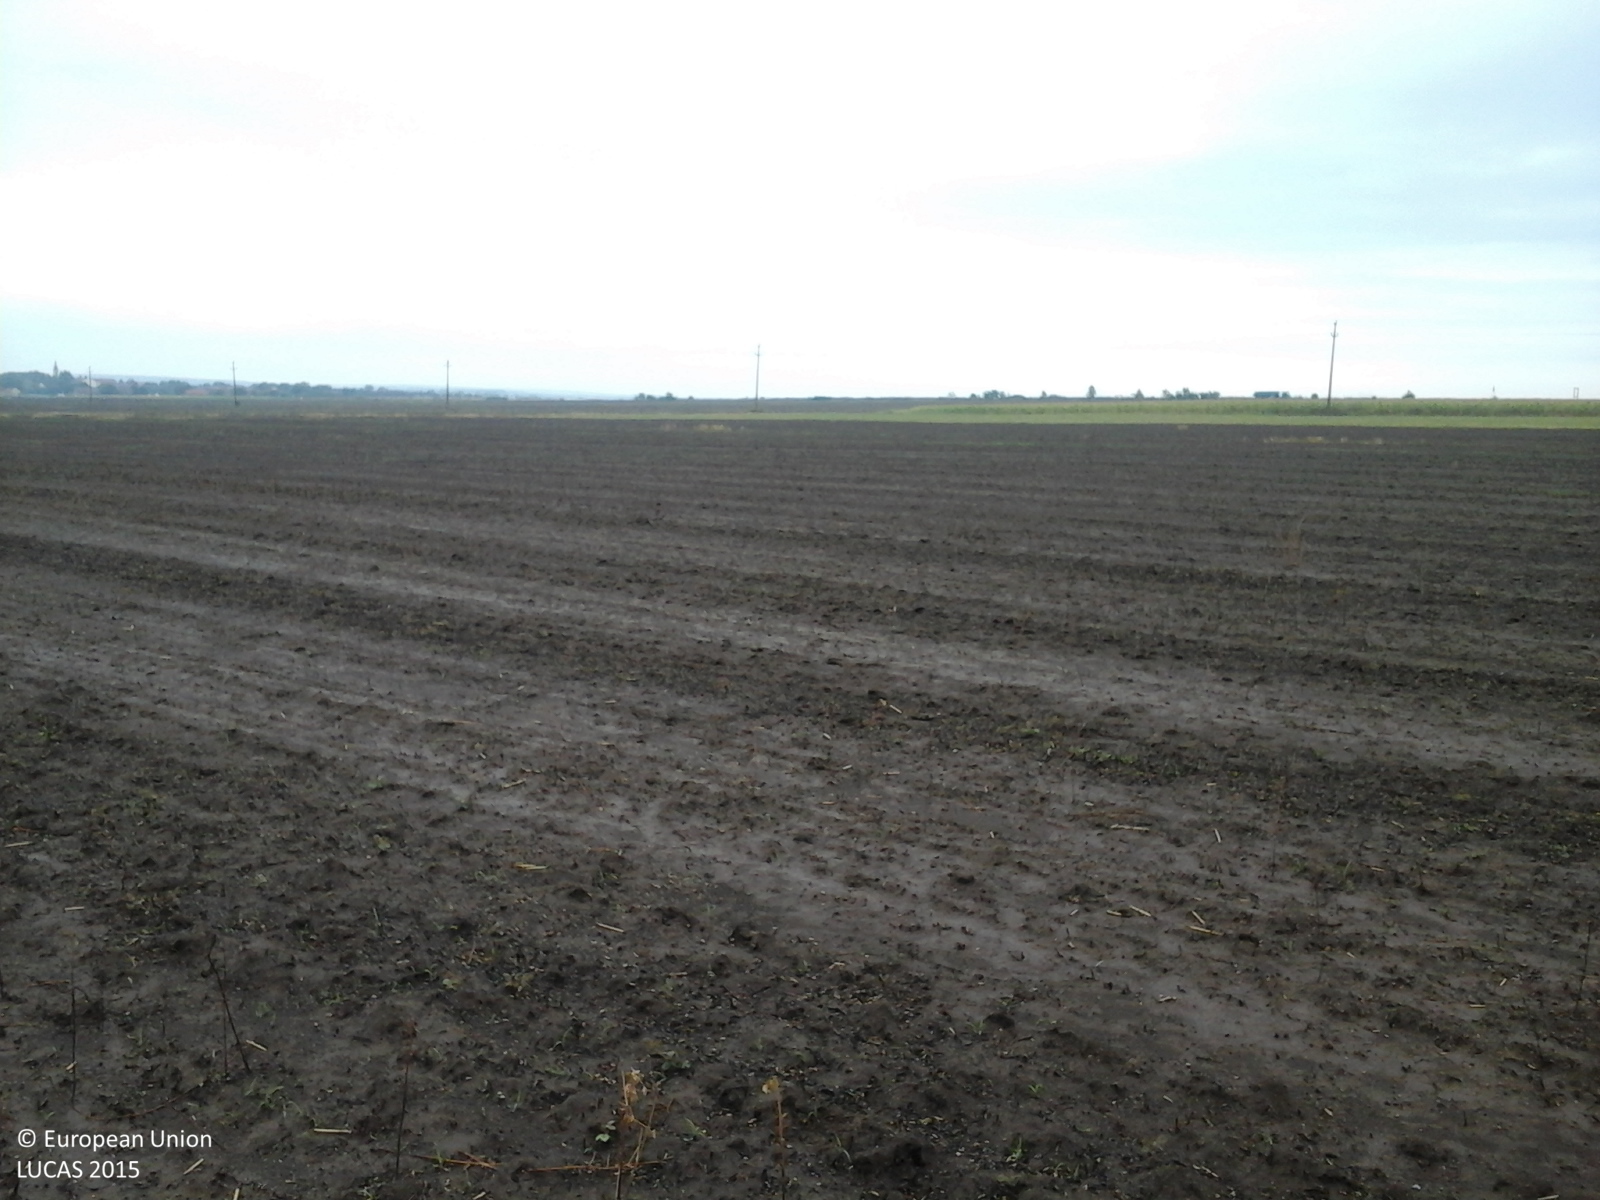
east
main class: Cropland
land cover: Common wheat
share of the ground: < 10 %
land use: Agriculture (excluding fallow land and kitchen gardens)
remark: Burnt area
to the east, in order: Common wheat; Grass margins; Tracks; Common wheat; Electric lines; Common wheat
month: August
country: RO
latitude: 45.9905
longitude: 21.4340
